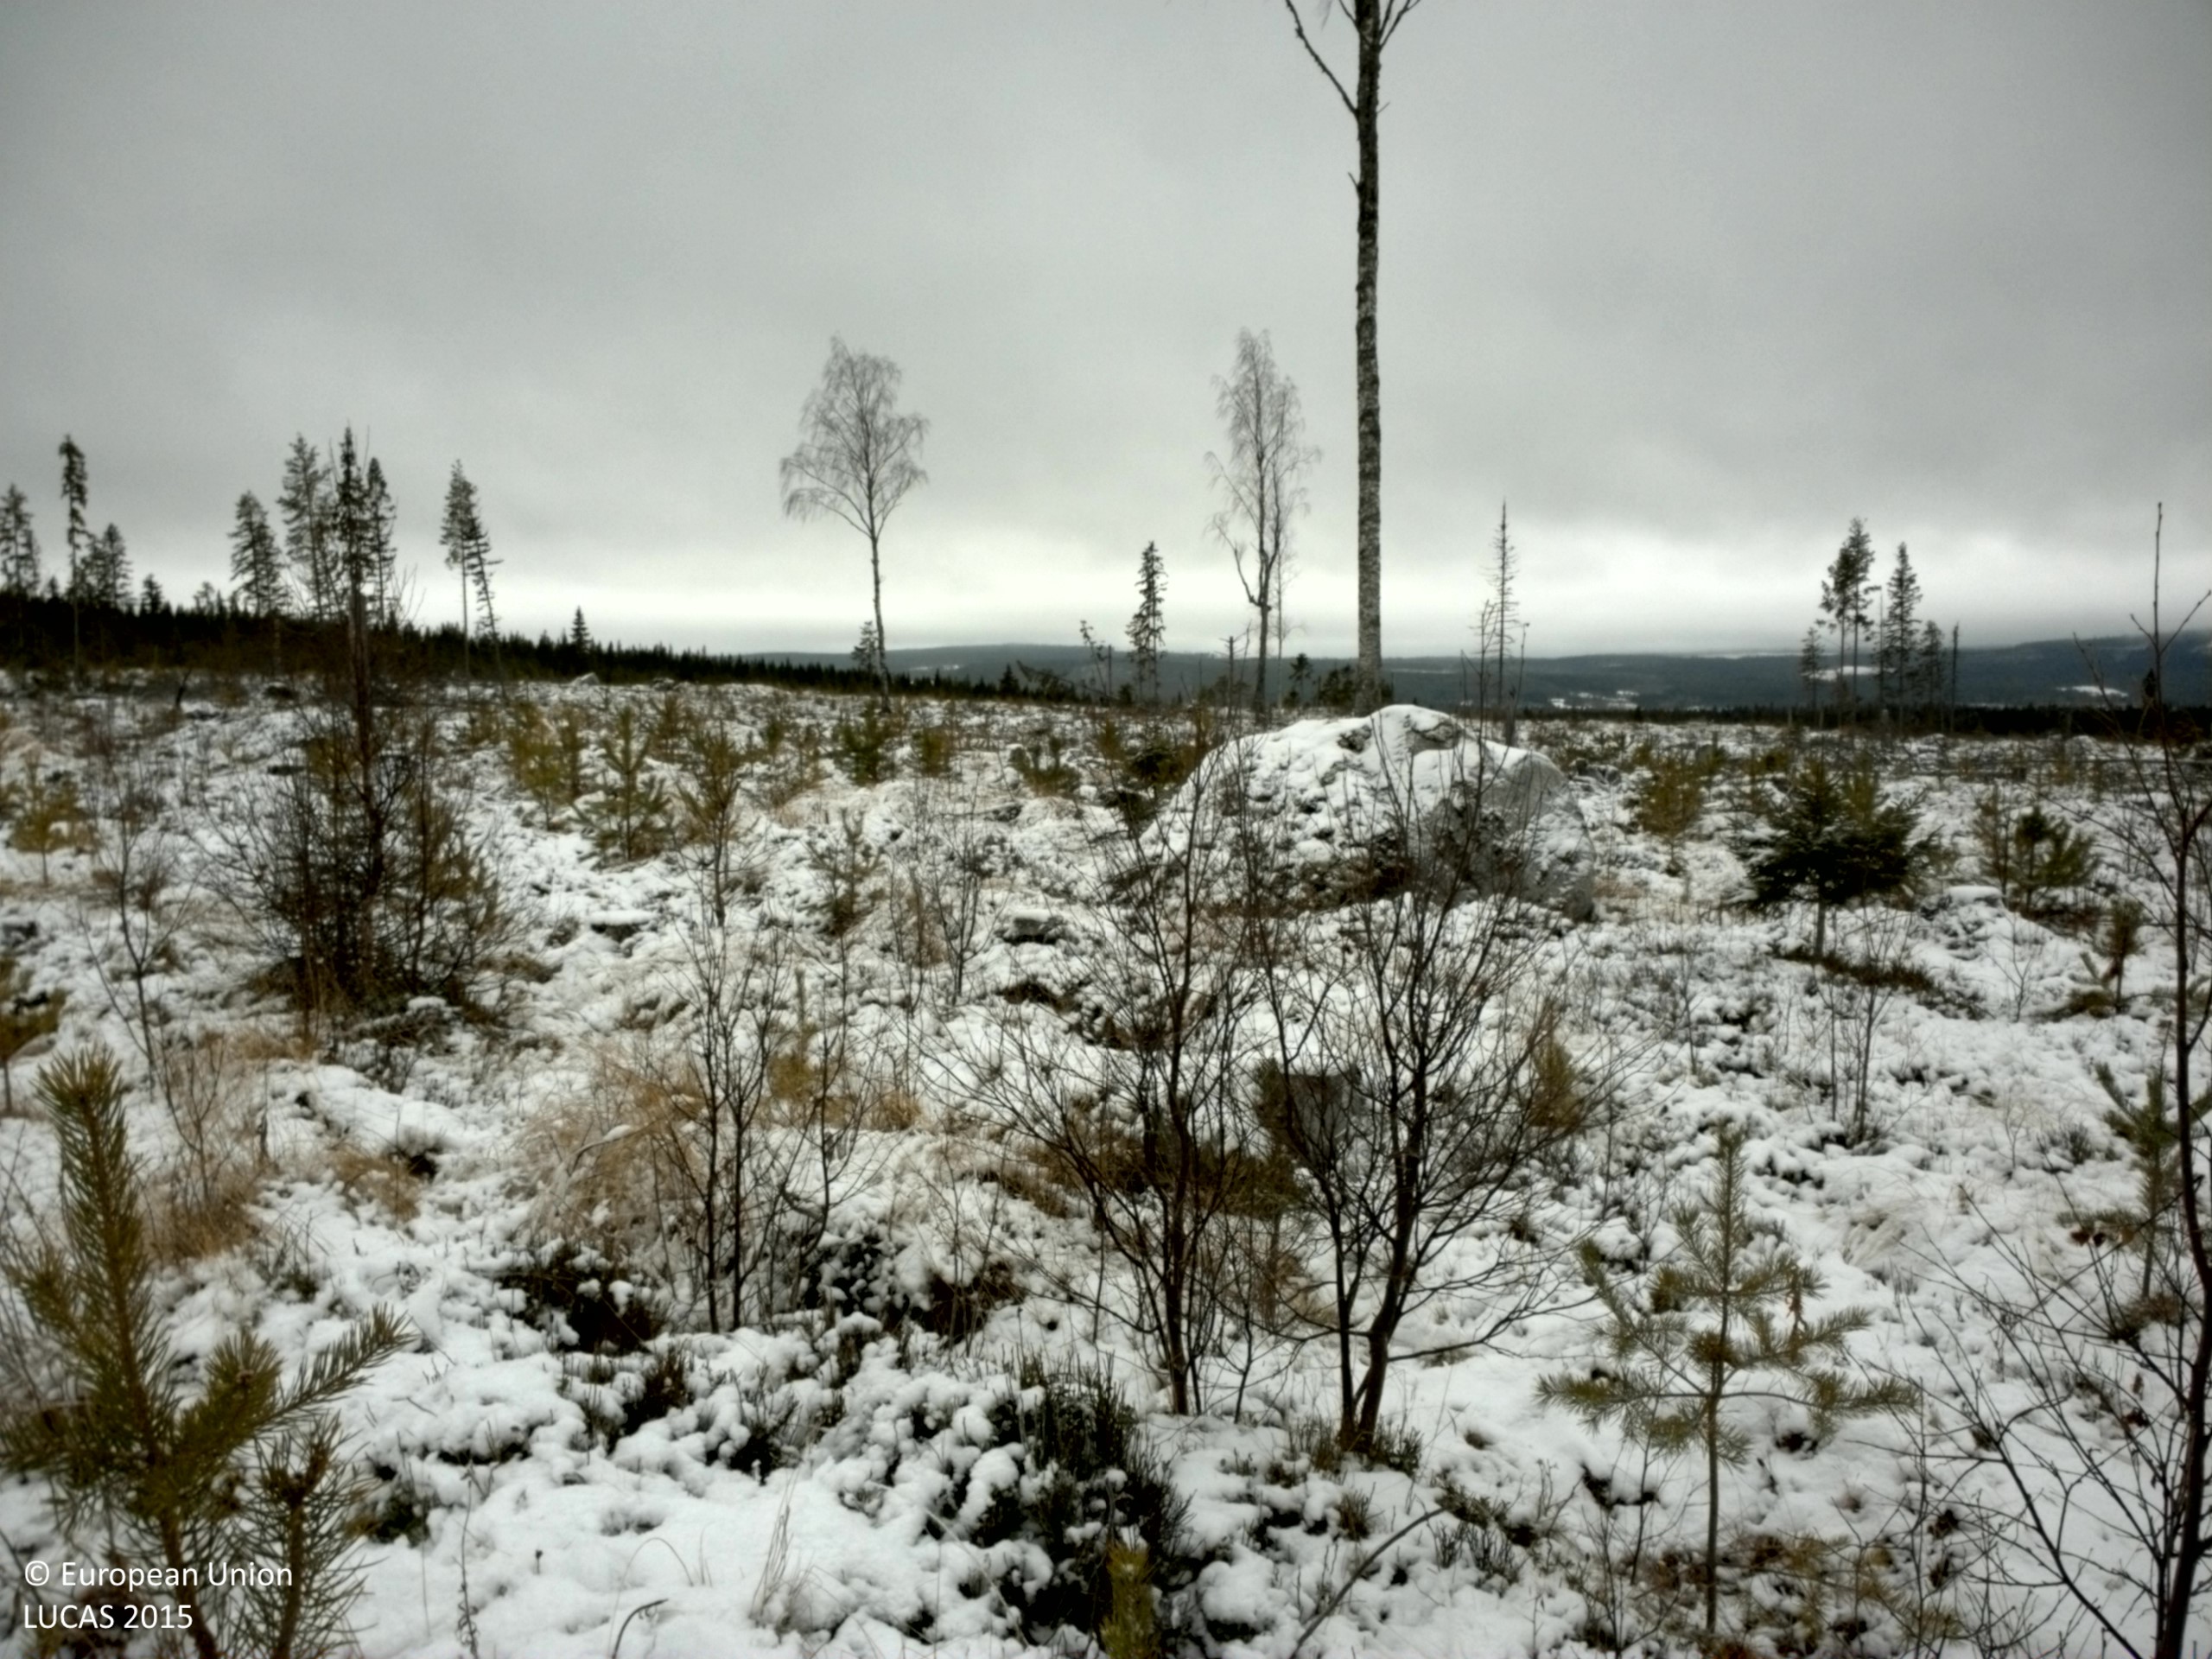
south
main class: Woodland
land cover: Pine dominated mixed woodland
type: boreal forest
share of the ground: 10 - 25 %
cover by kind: shrubs 50 %, lichens and mosses 25 %, coniferous forest trees 10 %, broadleaved forest trees 10 %, herbaceous plants 5 %
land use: Forestry
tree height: < 5 m
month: November
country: SE
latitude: 61.8235
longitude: 15.5449
